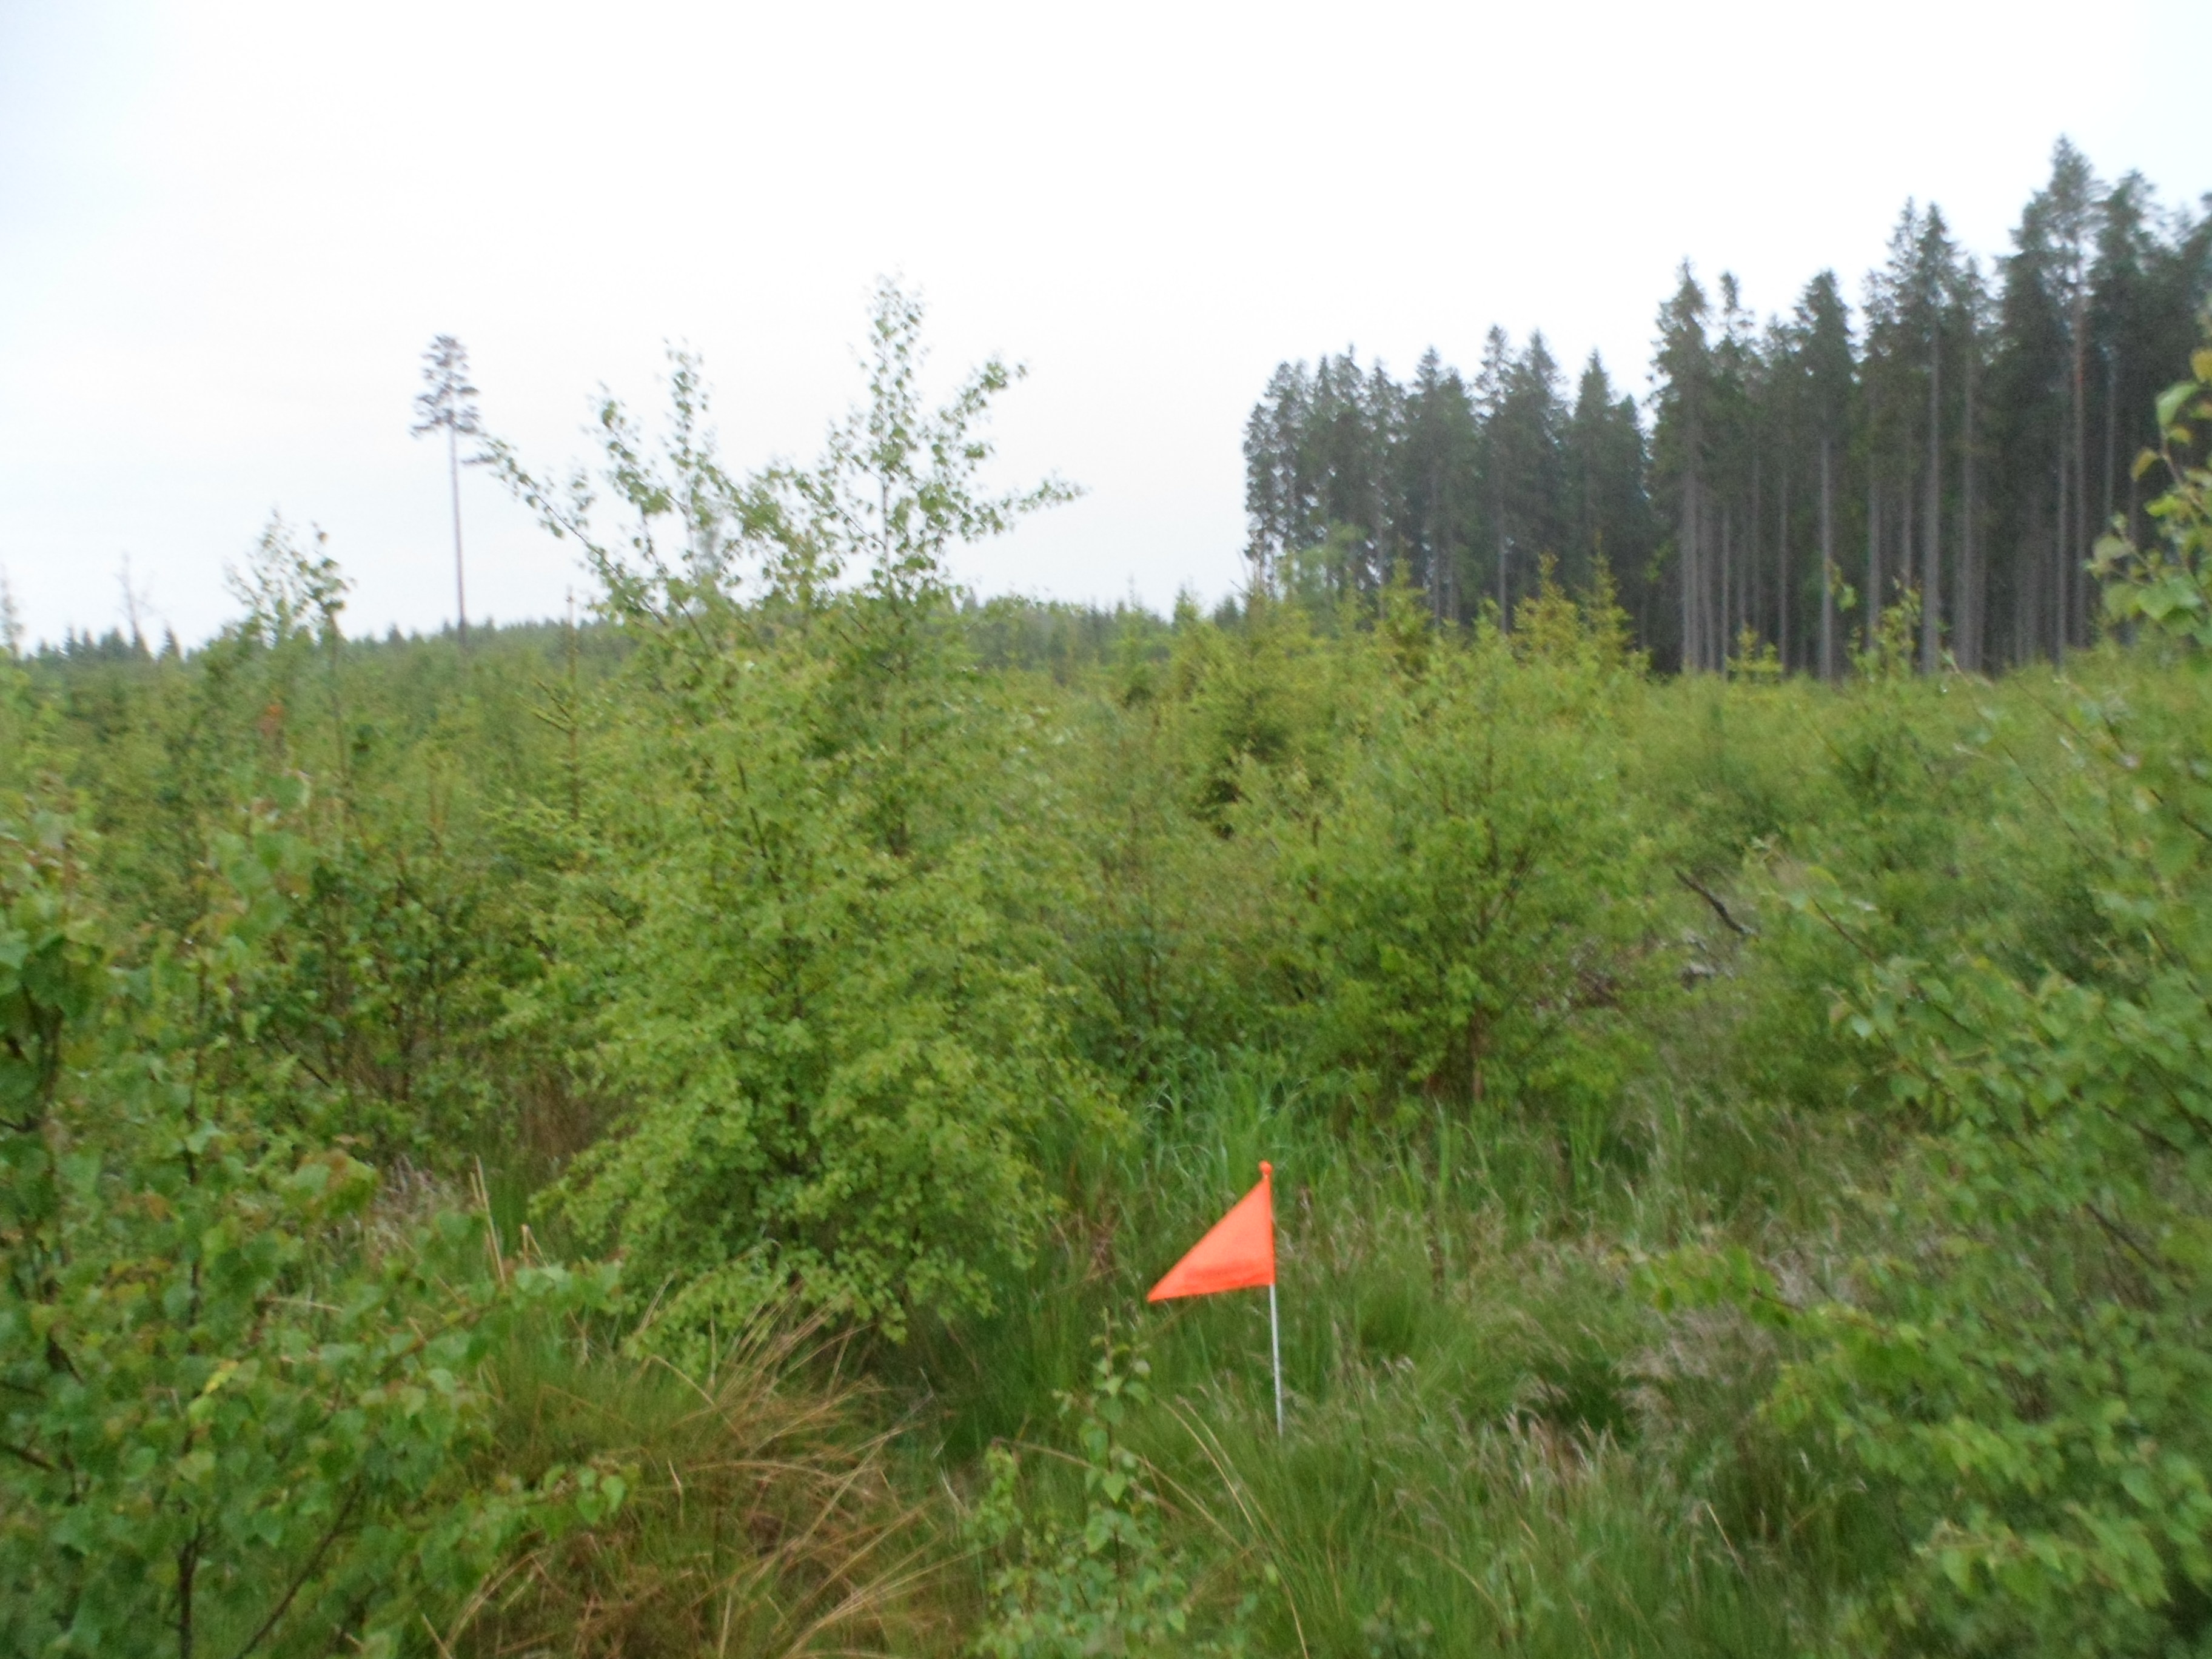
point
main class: Woodland
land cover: Broadleaved woodland
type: boreal forest
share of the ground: 50 - 75 %
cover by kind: broadleaved forest trees 65 %, herbaceous plants 20 %, shrubs 10 %, coniferous forest trees 5 %
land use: Forestry
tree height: > 5 m
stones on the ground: < 10 %
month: June
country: SE
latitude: 57.6316
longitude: 14.1989
